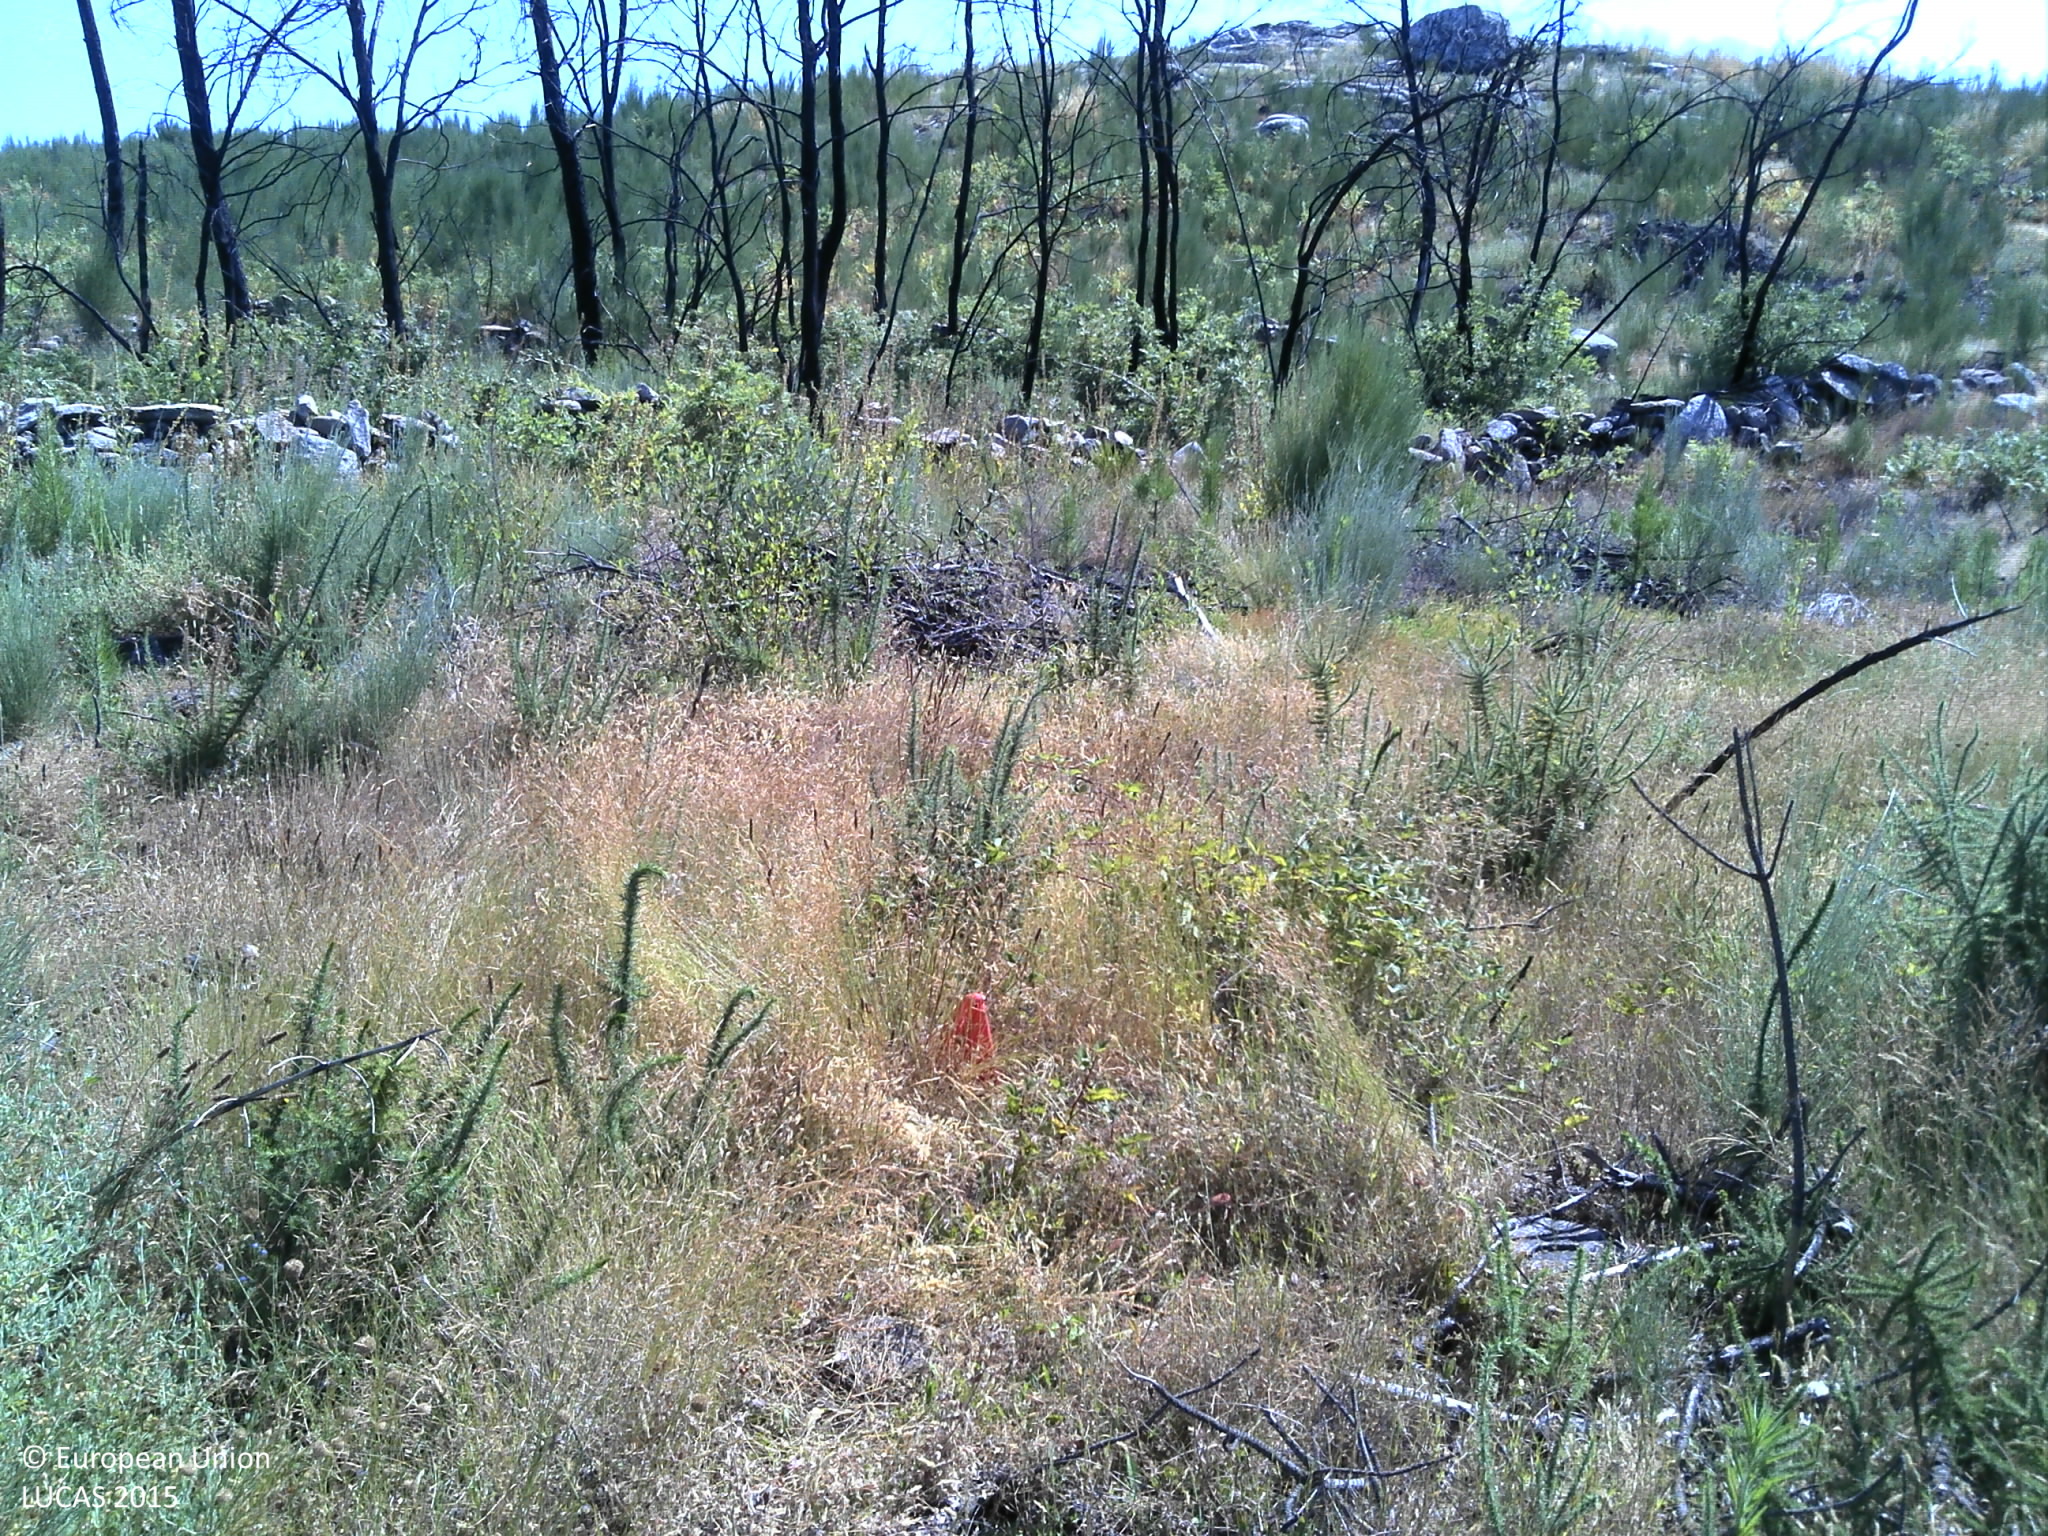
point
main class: Shrubland
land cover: Shrubland without tree cover
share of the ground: > 75 %
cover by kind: shrubs 90 %, herbaceous plants 10 %
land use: Abandoned areas
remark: Burnt area
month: July
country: PT
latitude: 40.7670
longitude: -7.4947
